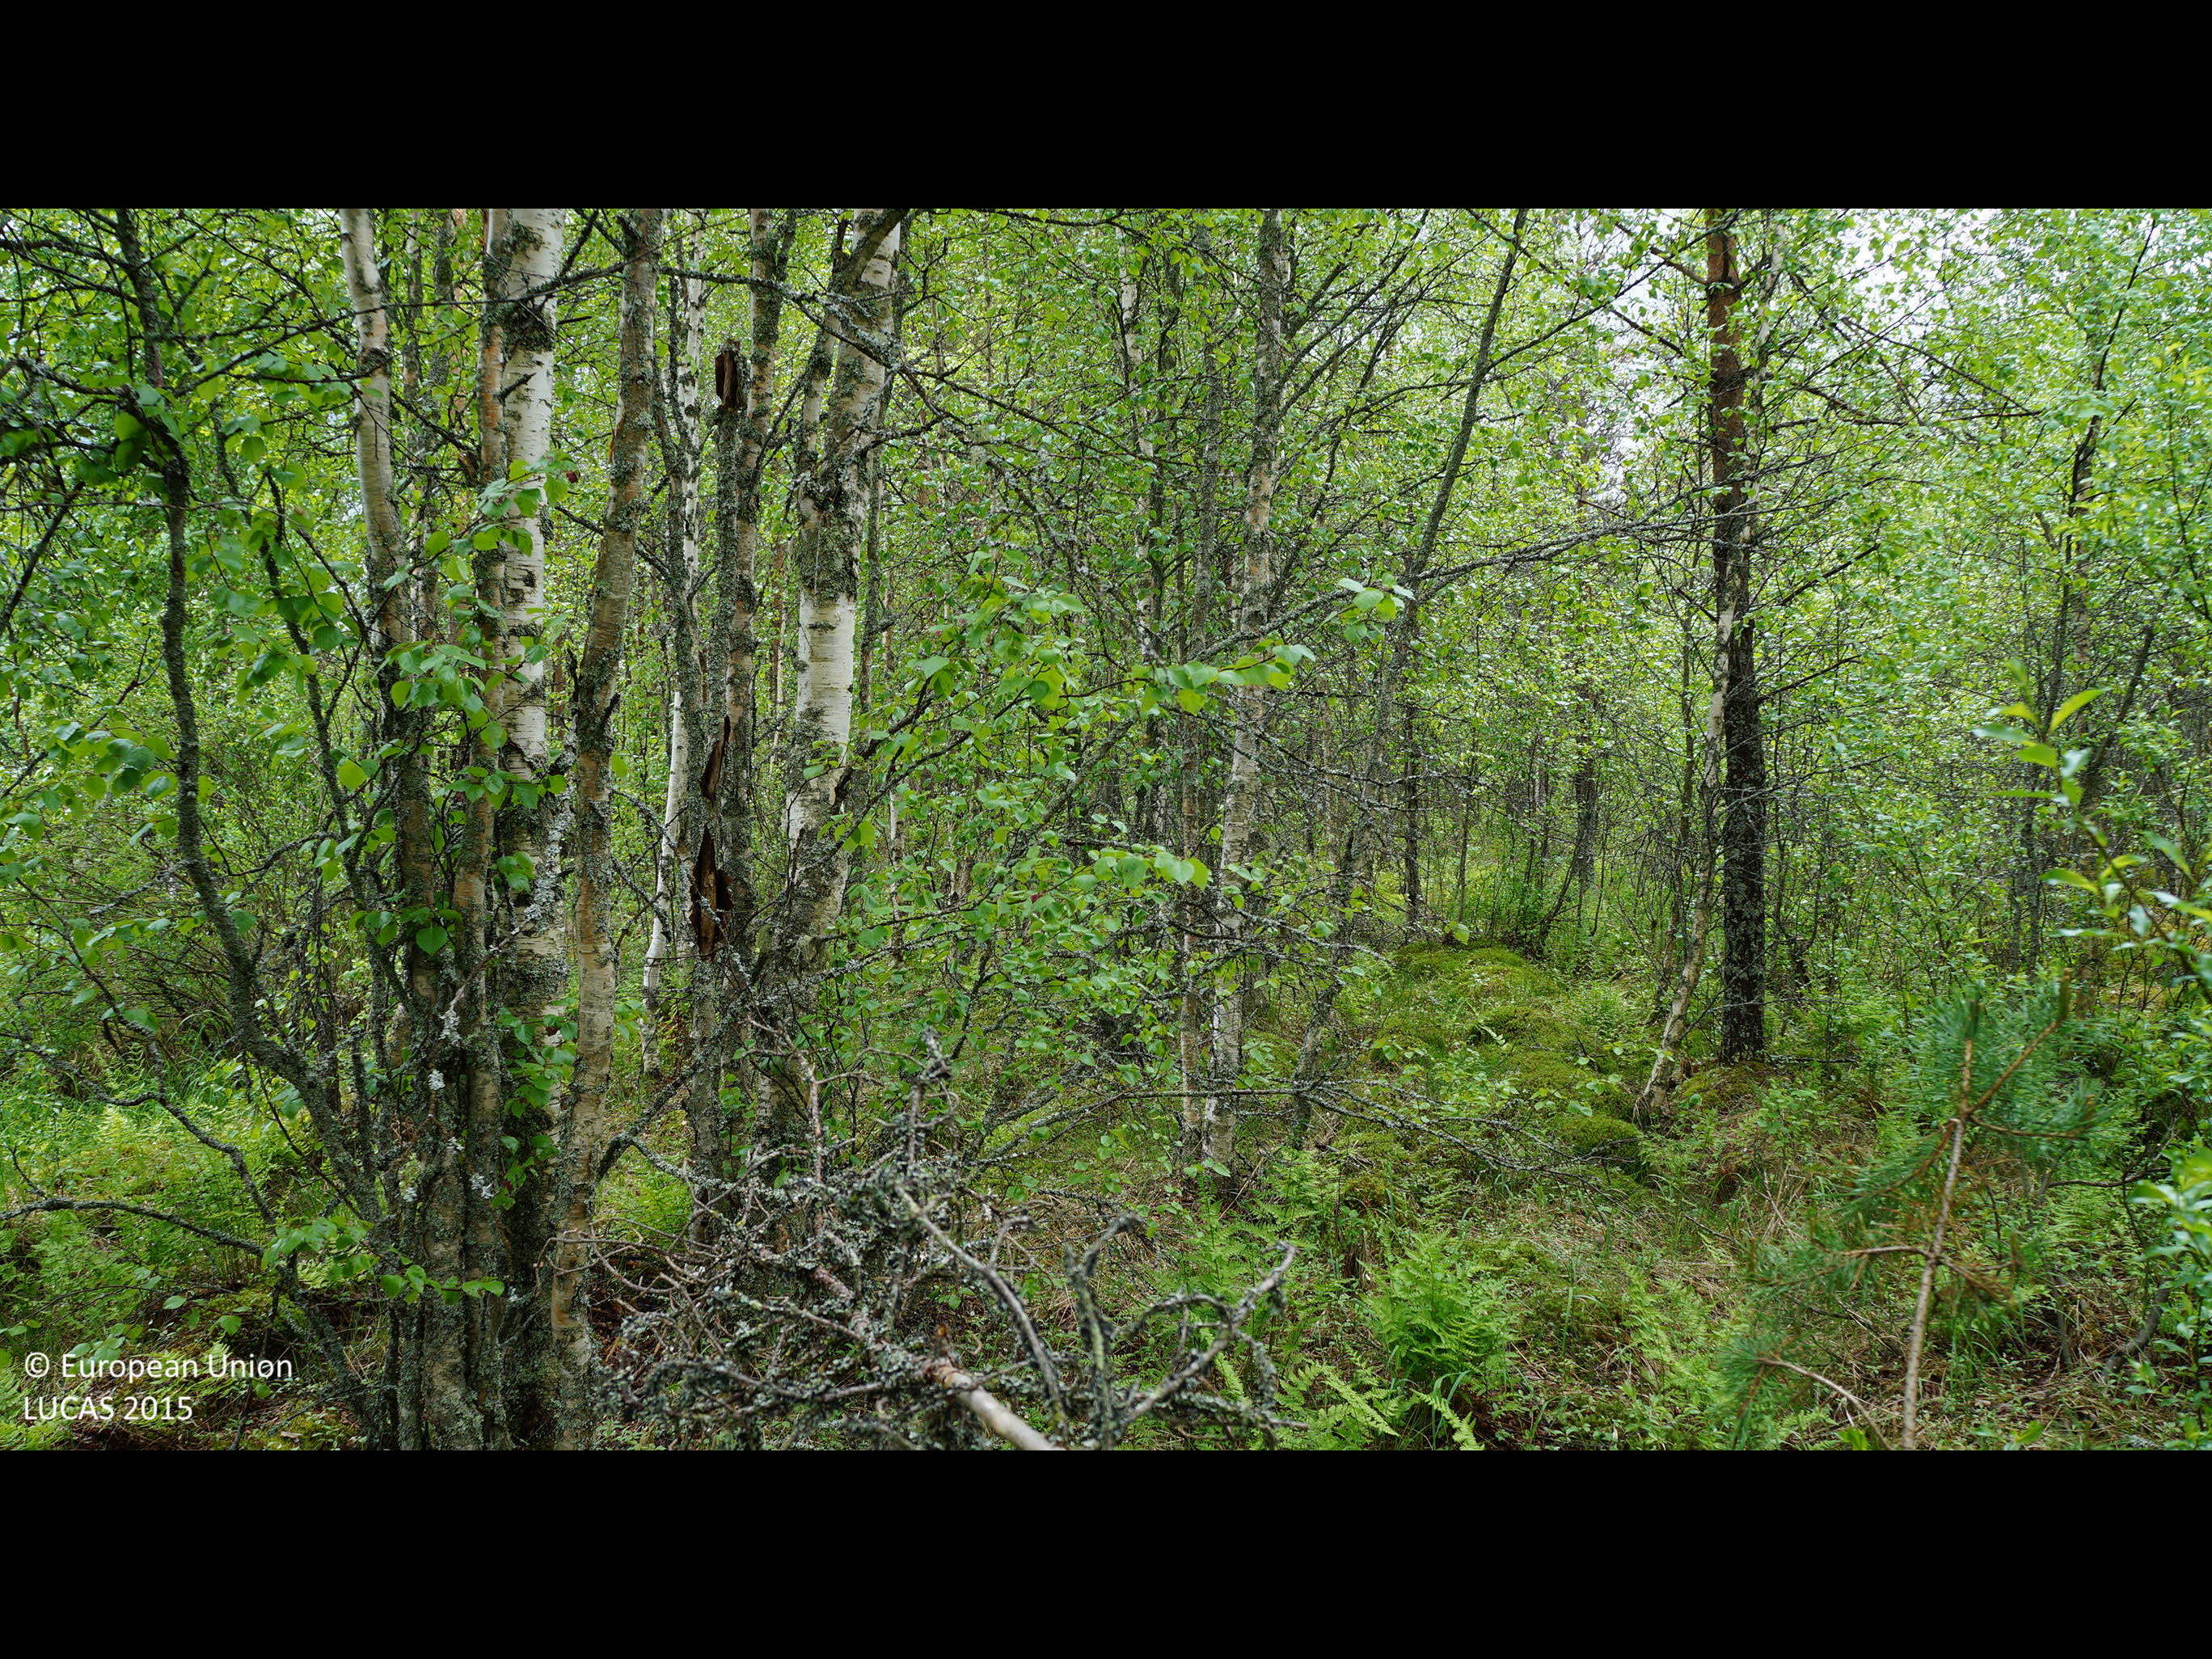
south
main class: Woodland
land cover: Broadleaved woodland
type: non-riverine alder, birch or aspen forest
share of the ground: > 75 %
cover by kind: broadleaved forest trees 90 %, shrubs 5 %, herbaceous plants 5 %
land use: Forestry
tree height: > 5 m
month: June
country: FI
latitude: 63.9888
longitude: 25.2343
